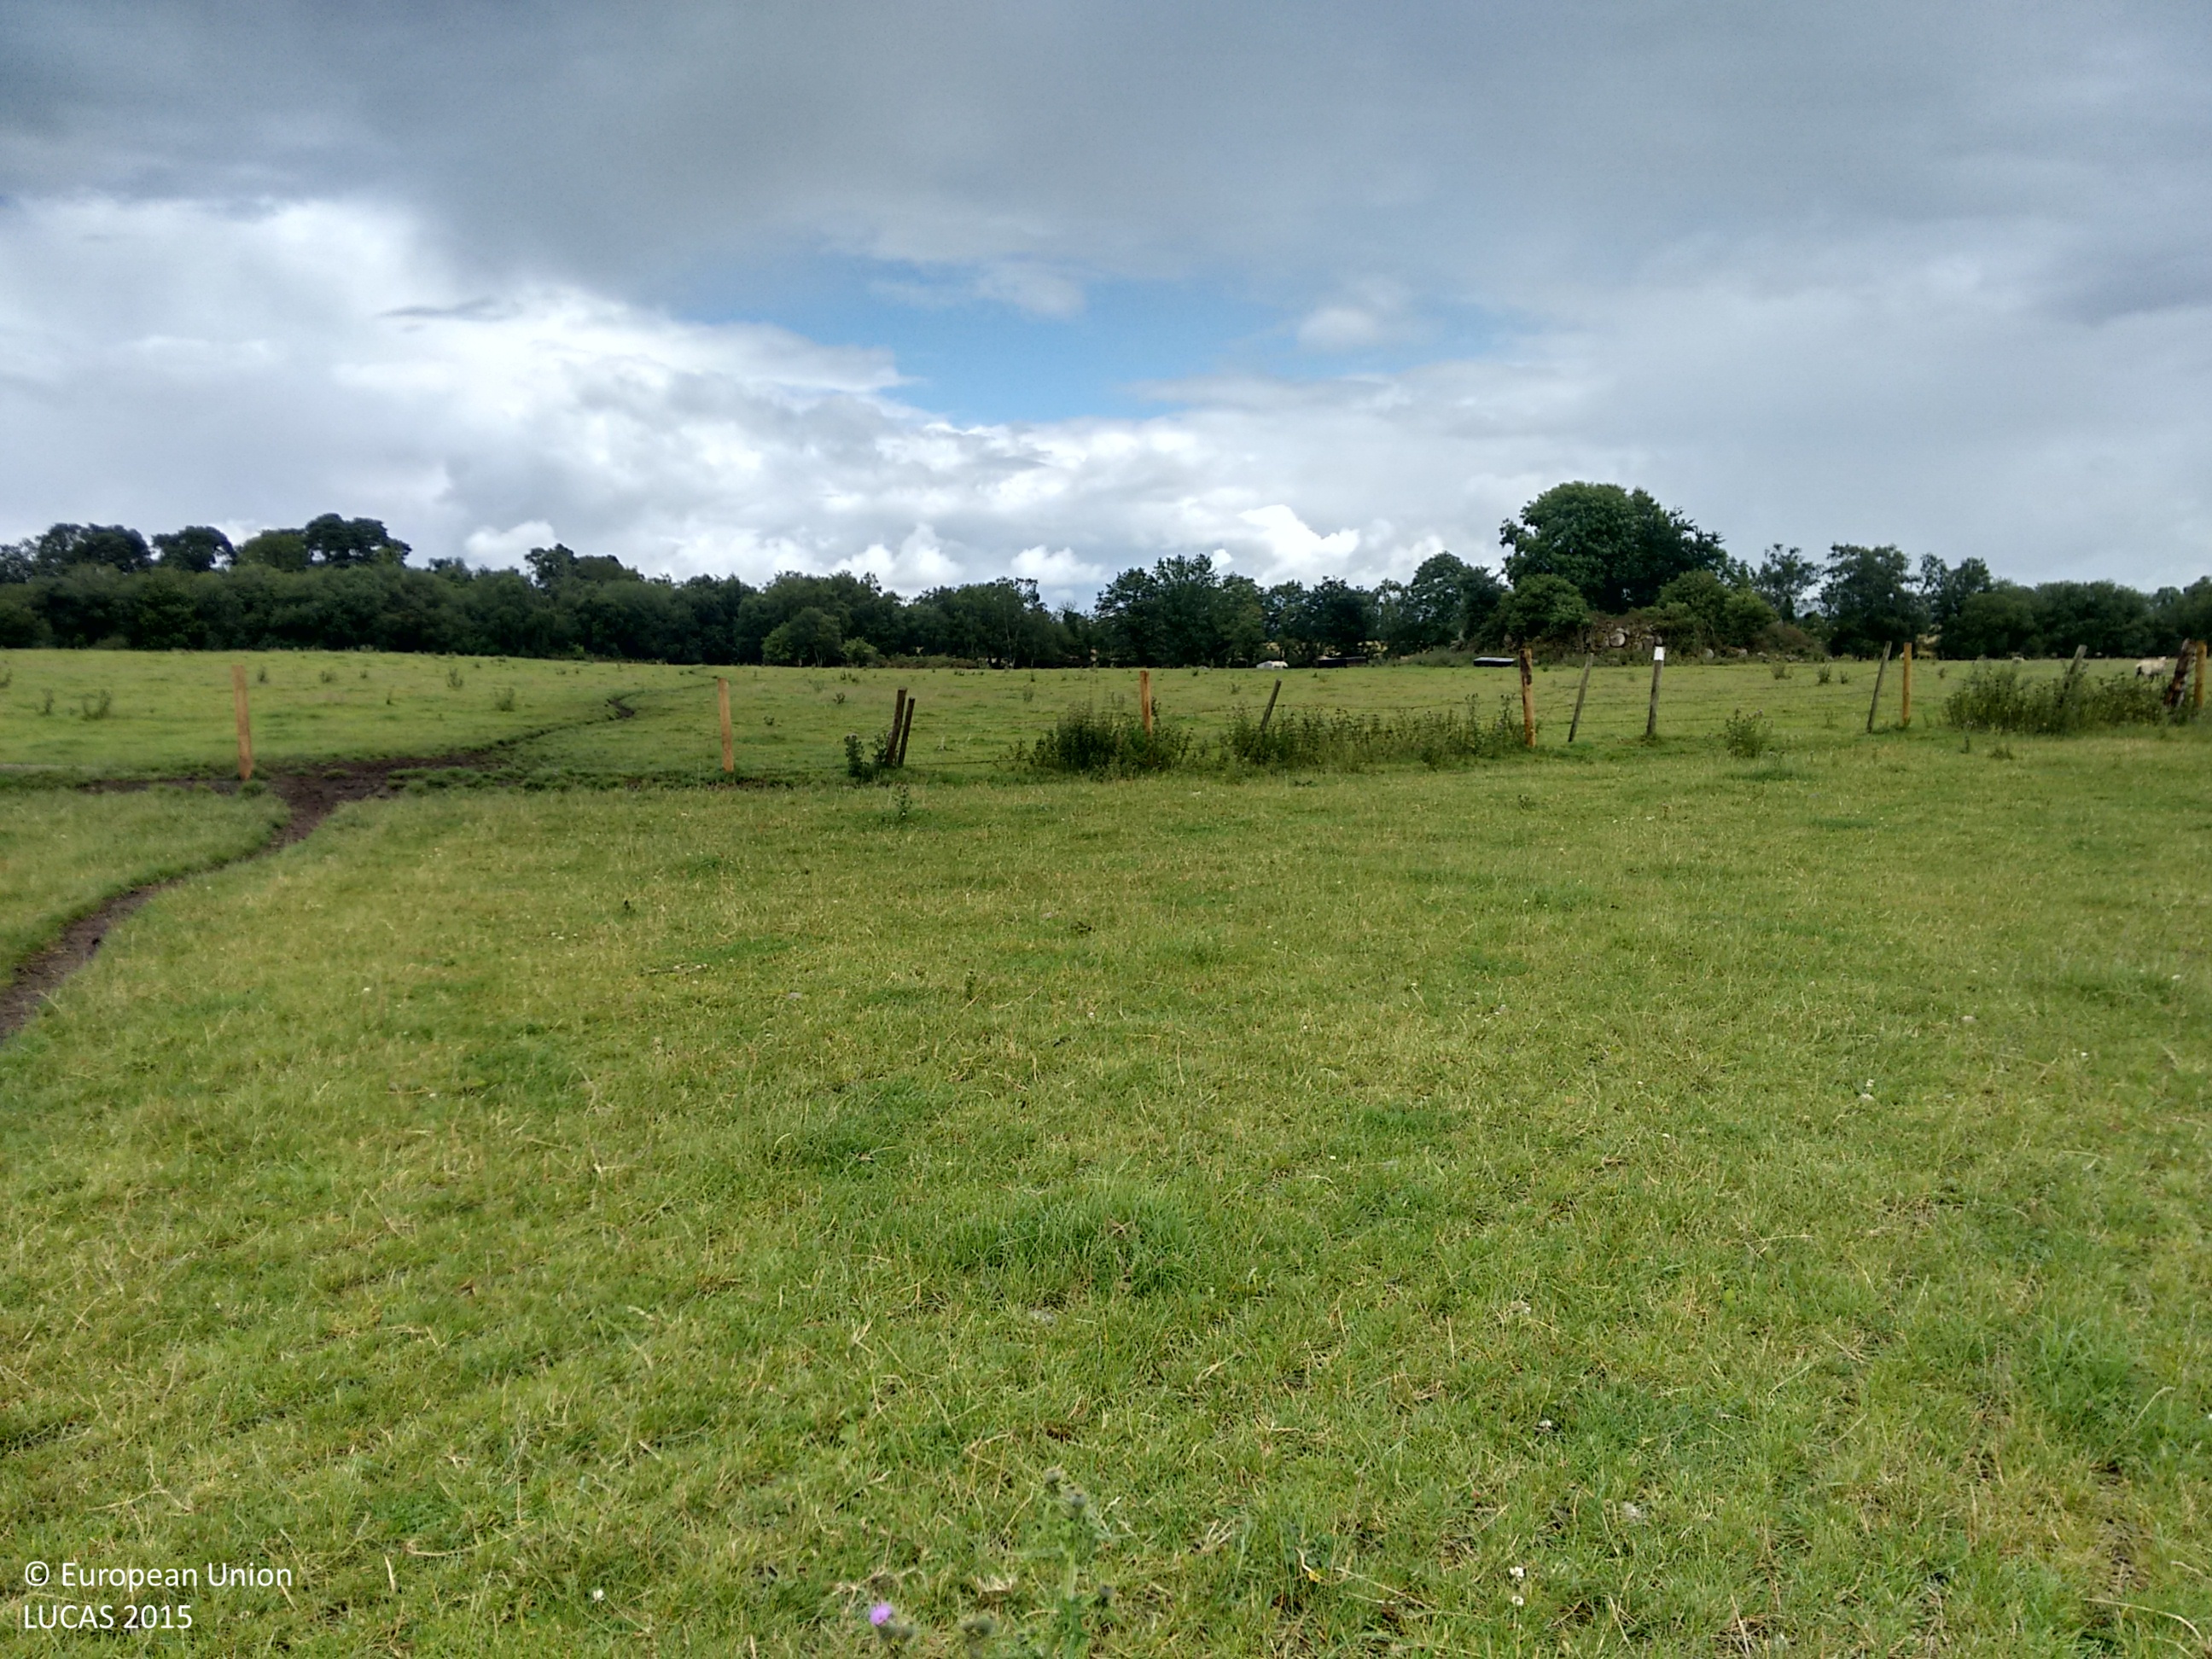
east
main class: Grassland
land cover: Grassland without tree/shrub cover
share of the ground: > 75 %
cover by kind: herbaceous plants 95 %, unconsolidated bare surface 5 %
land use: Agriculture (excluding fallow land and kitchen gardens)
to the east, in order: Grassland without tree/shrub cover; Fences; Grassland without tree/shrub cover; Rocks and stones; Broadleaved woodland; Rocks and stones; Grassland without tree/shrub cover; Fences; Rocks and stones; Grassland with sparse tree/shrub cover; Fences; Shruby margins; Ditches and canals; Spontaneously vegetated surfaces
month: July
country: IE
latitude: 52.7609
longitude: -6.7162
